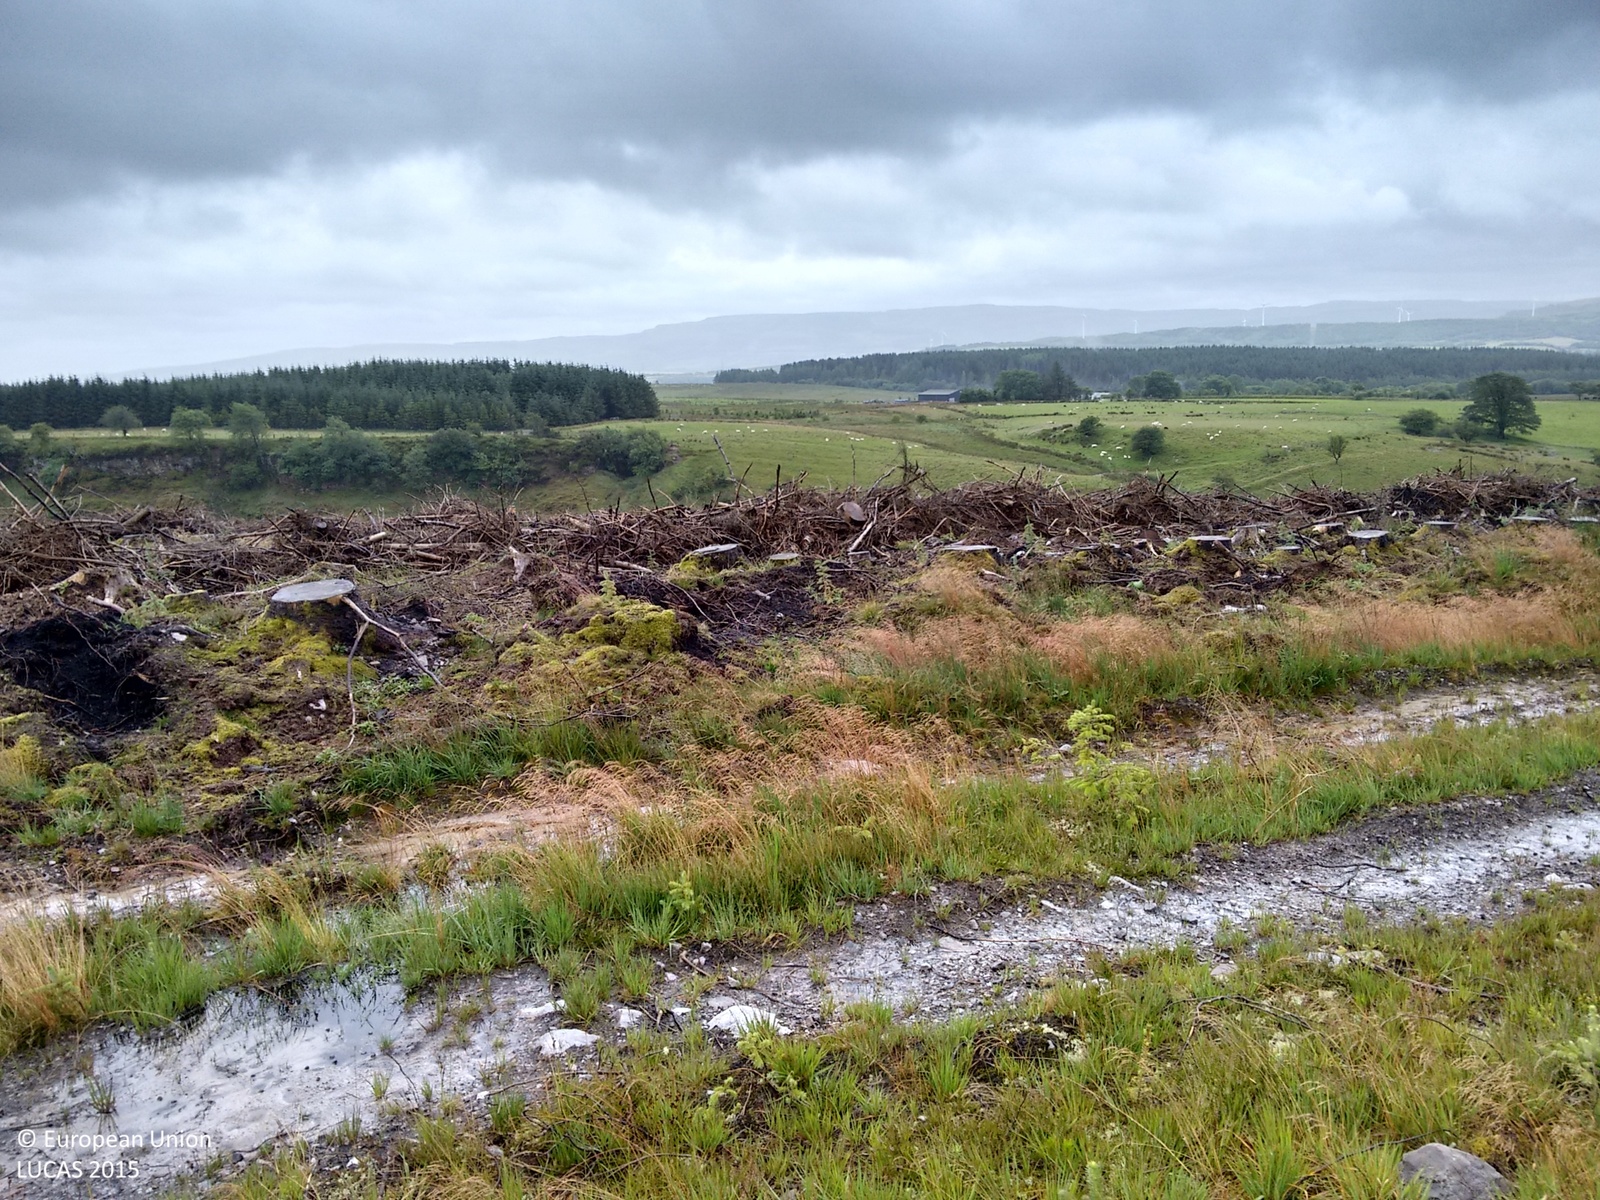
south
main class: Grassland
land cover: Spontaneously vegetated surfaces
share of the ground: > 75 %
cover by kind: herbaceous plants 70 %, unconsolidated bare surface 30 %
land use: Forestry
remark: Clear cut
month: July
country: GB
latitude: 51.8034
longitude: -3.6470
